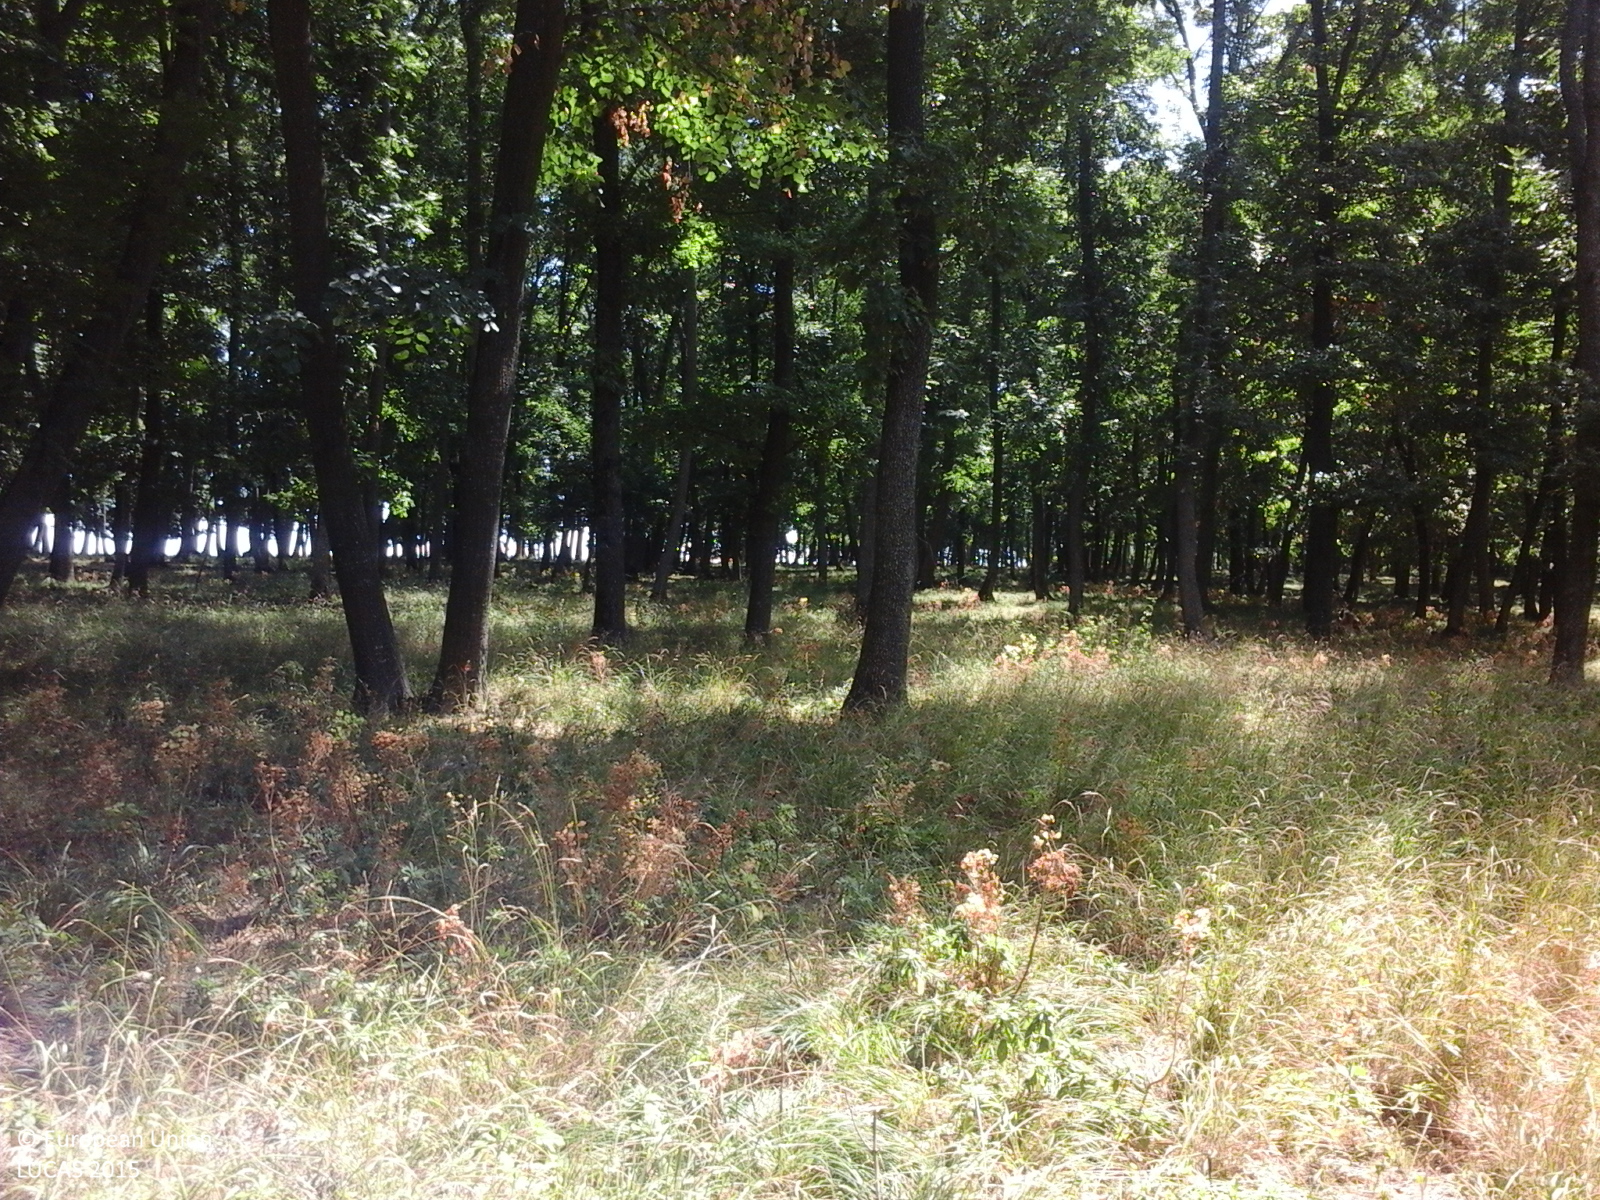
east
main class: Woodland
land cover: Broadleaved woodland
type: acidophilous oak and oak-birch forest
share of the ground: > 75 %
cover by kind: broadleaved forest trees 100 %
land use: Forestry
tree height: > 5 m
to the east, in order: Broadleaved woodland; Tracks; Grassland without tree/shrub cover
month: July
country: RO
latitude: 46.1222
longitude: 27.8608
